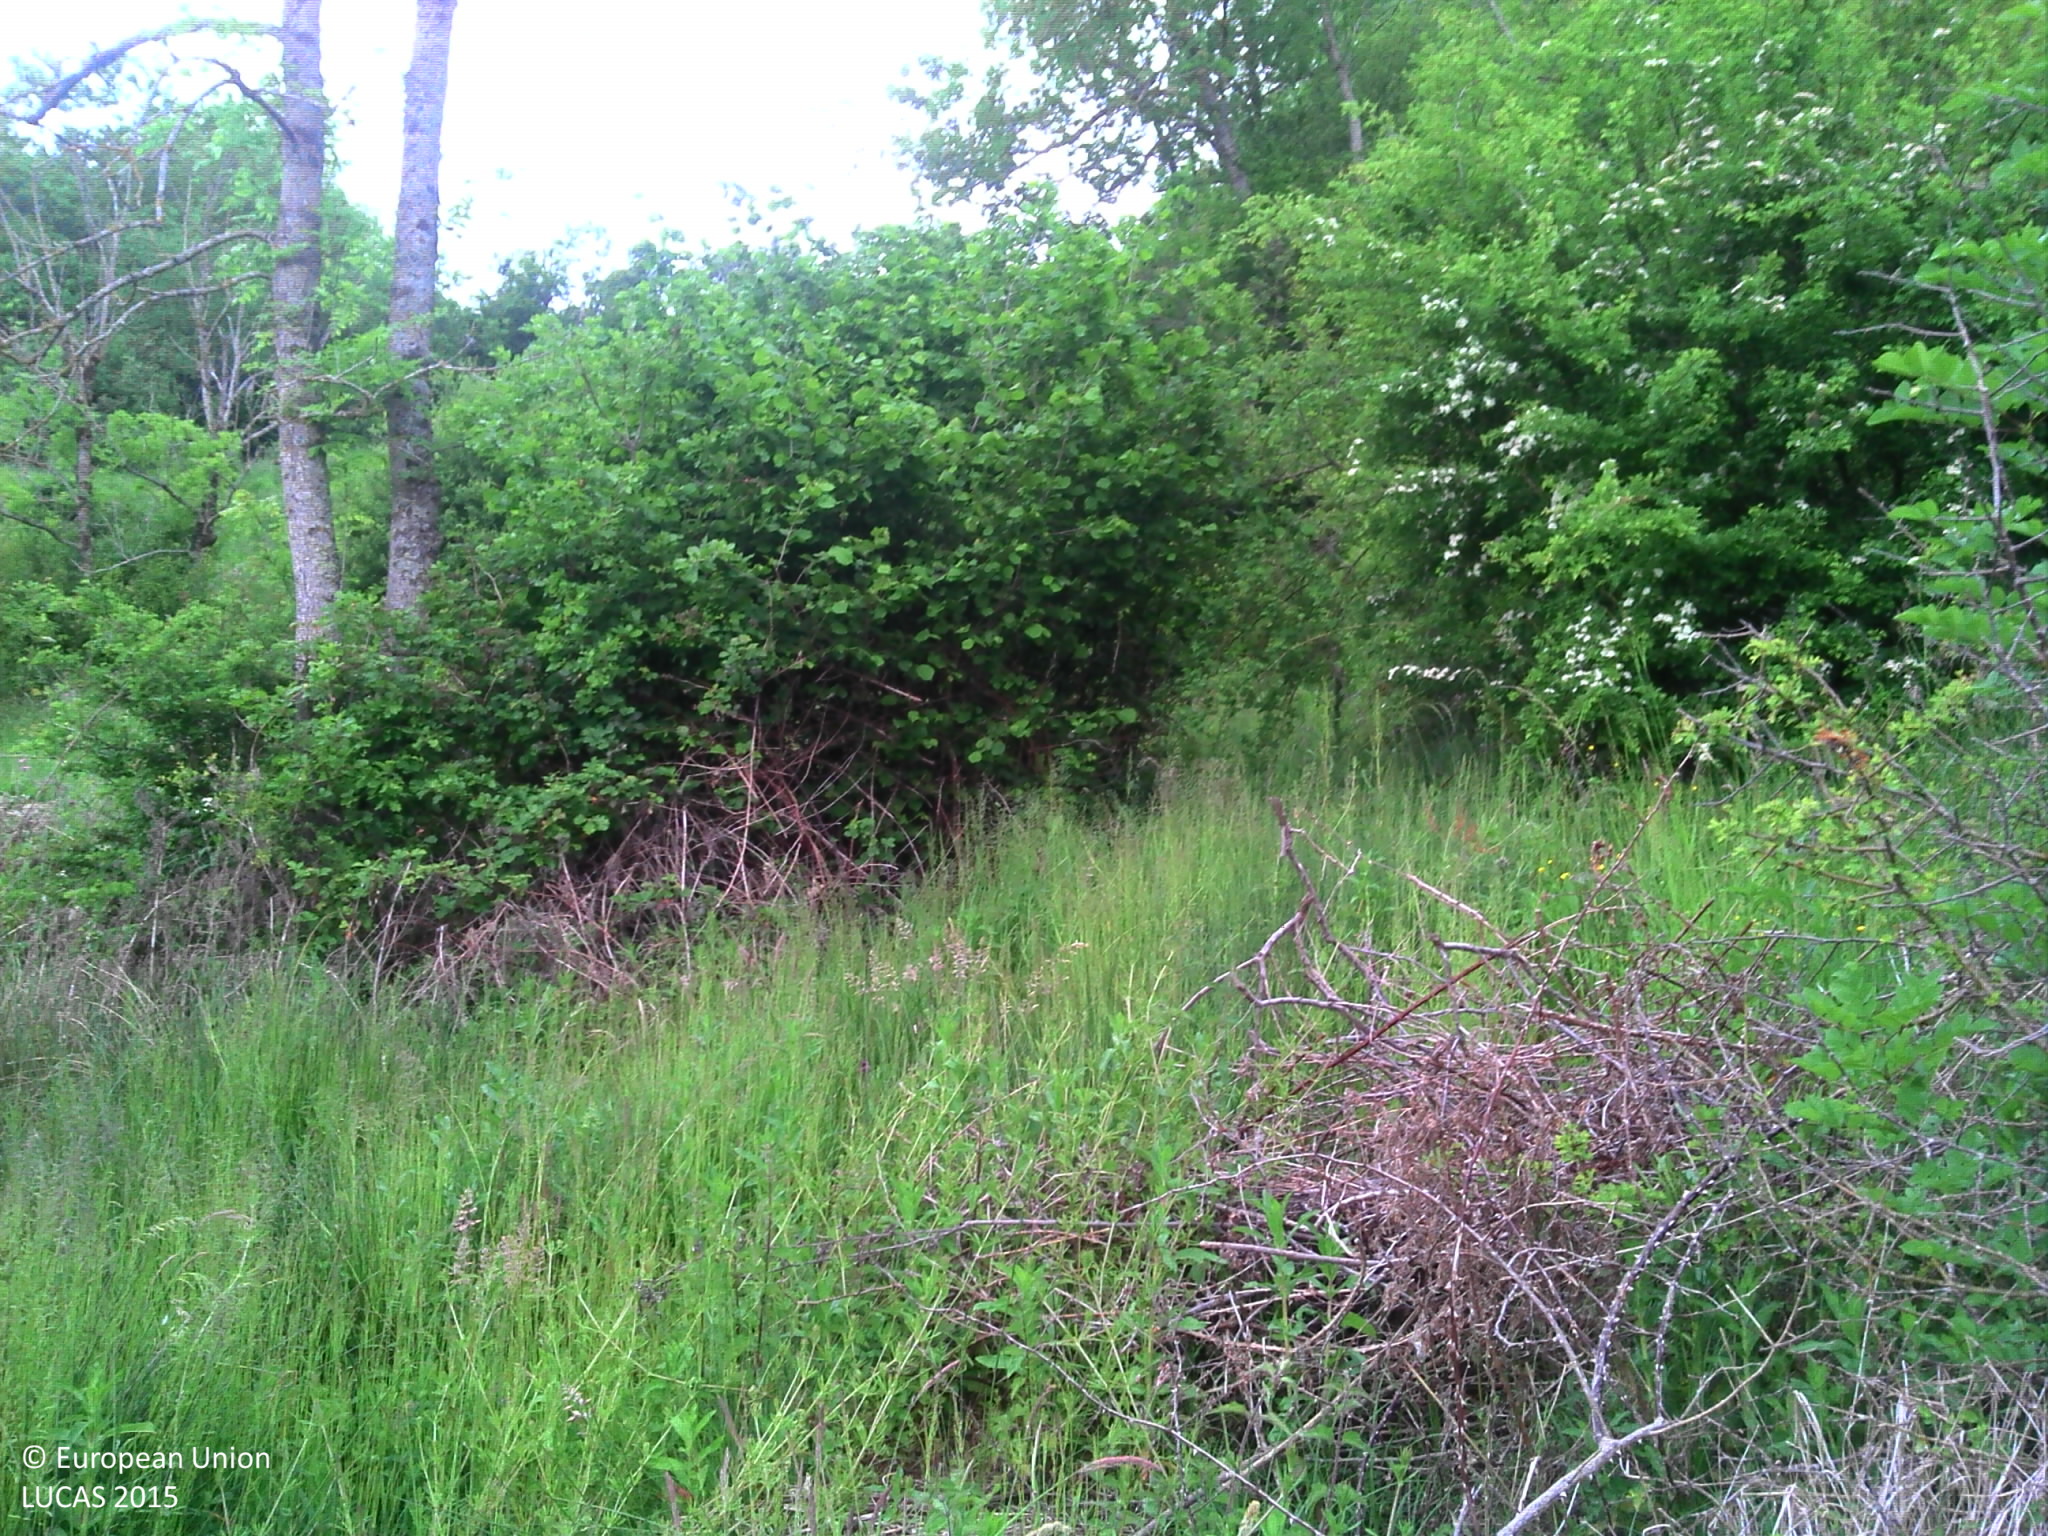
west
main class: Shrubland
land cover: Shrubland without tree cover
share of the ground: > 75 %
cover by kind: herbaceous plants 60 %, shrubs 40 %
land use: Agriculture (excluding fallow land and kitchen gardens)
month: May
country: FR
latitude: 45.2789
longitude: 3.1049
